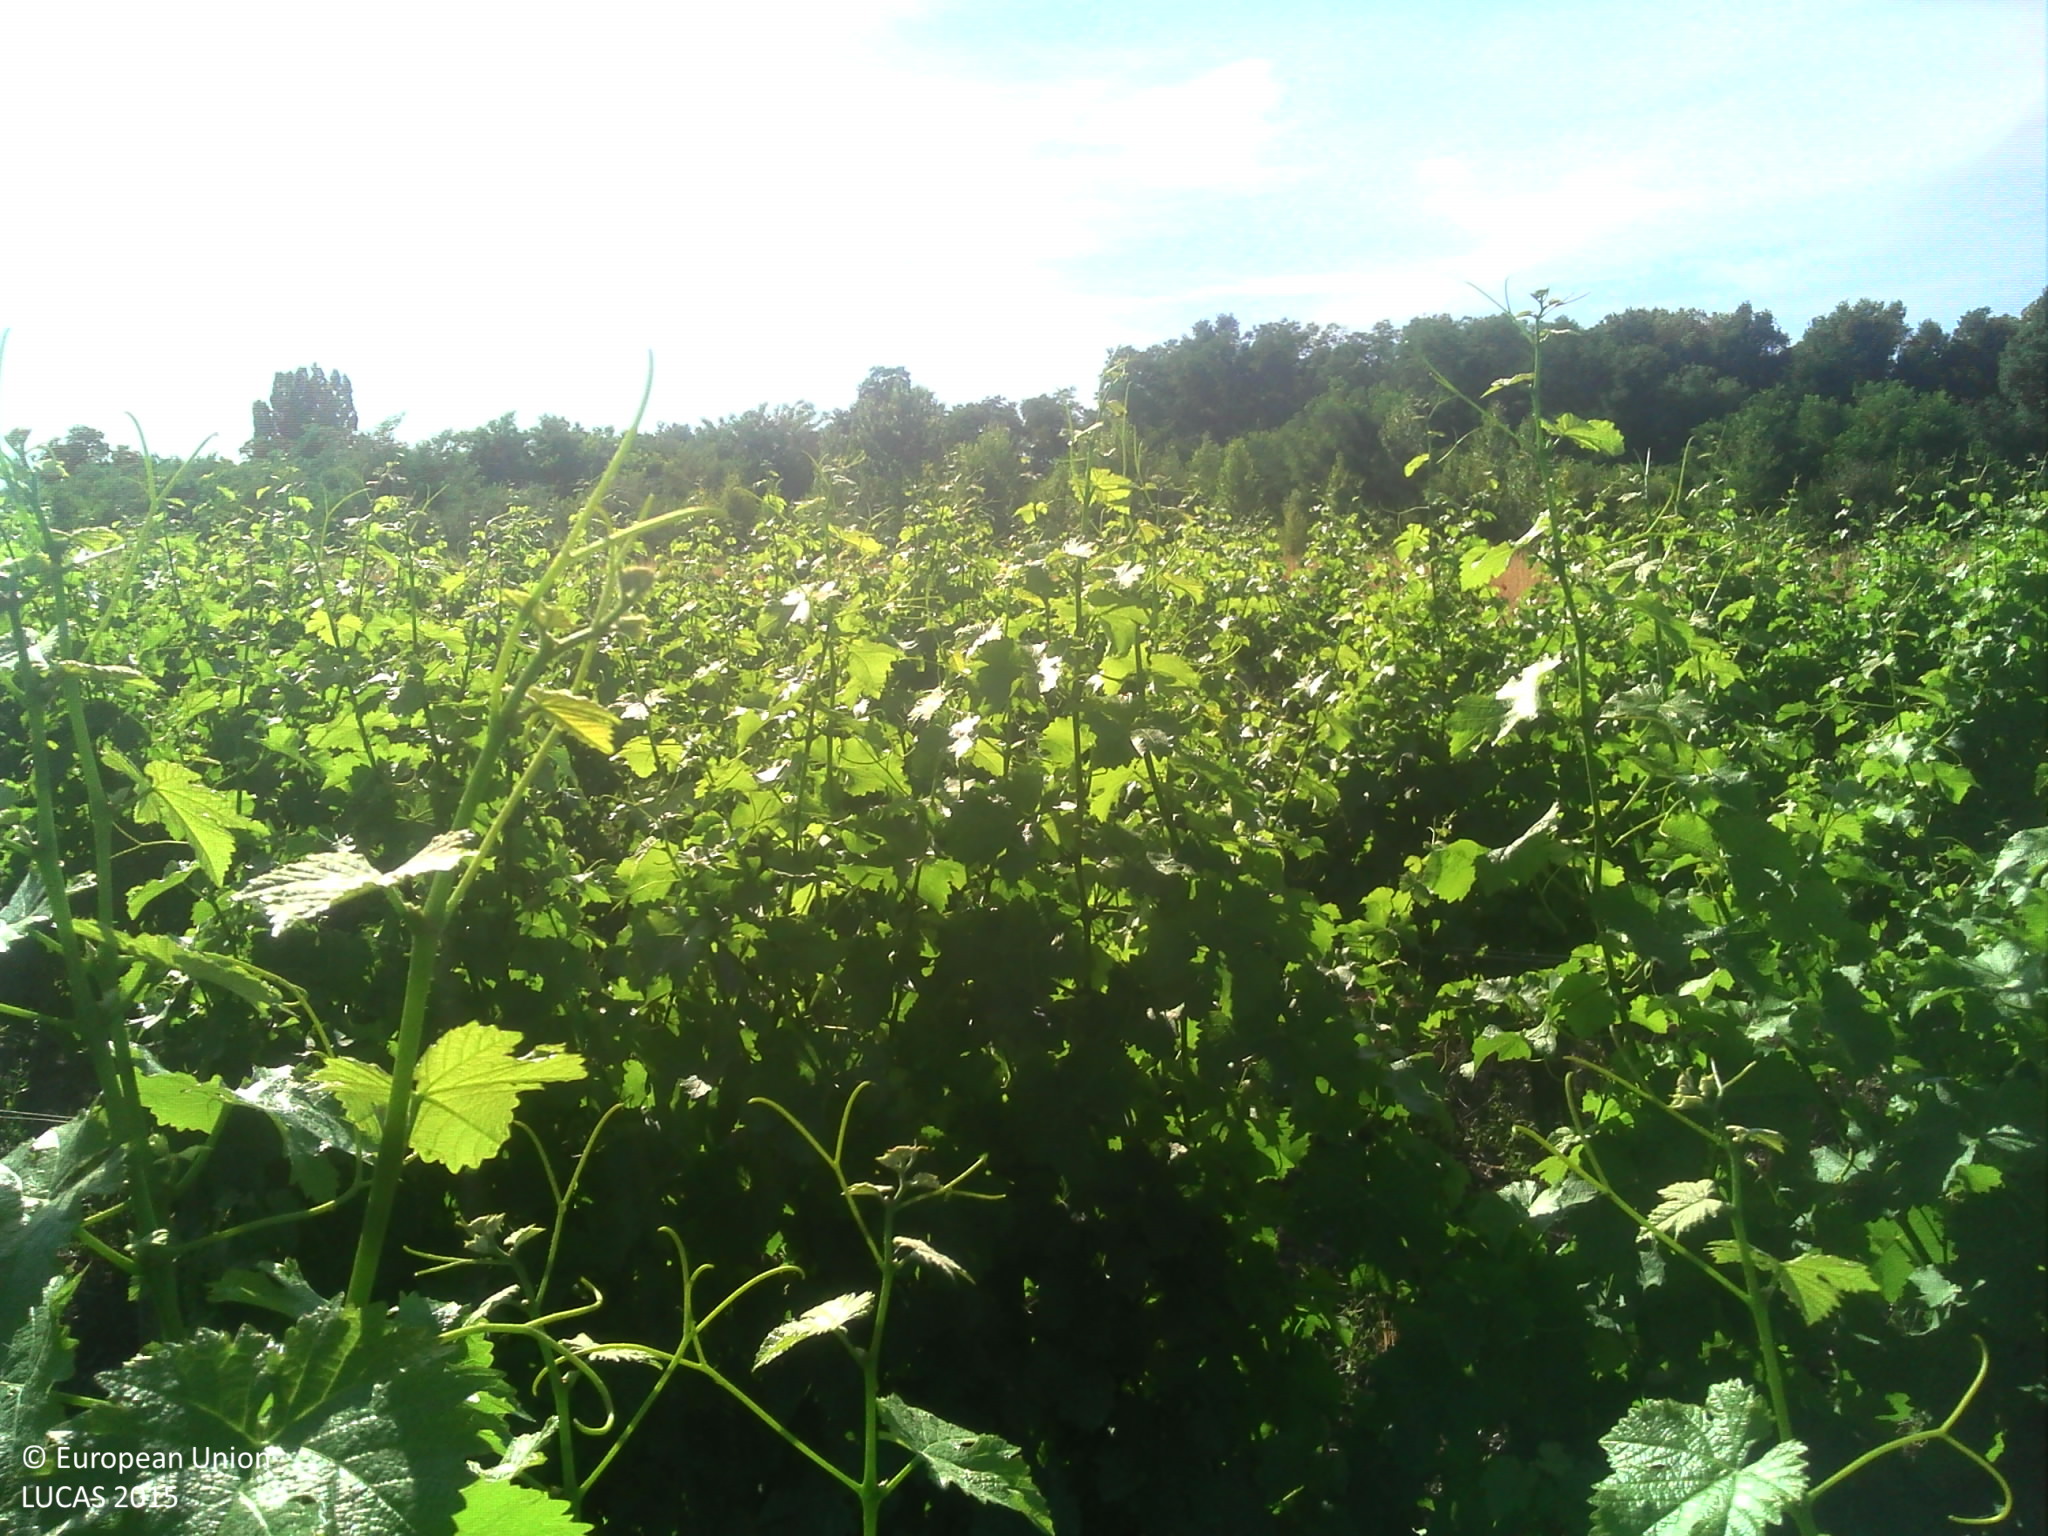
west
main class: Cropland
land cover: Vineyards
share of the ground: 25 - 50 %
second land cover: Other bare soil
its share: > 75 %
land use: Agriculture (excluding fallow land and kitchen gardens)
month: June
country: FR
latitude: 47.2764
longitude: 1.4602
